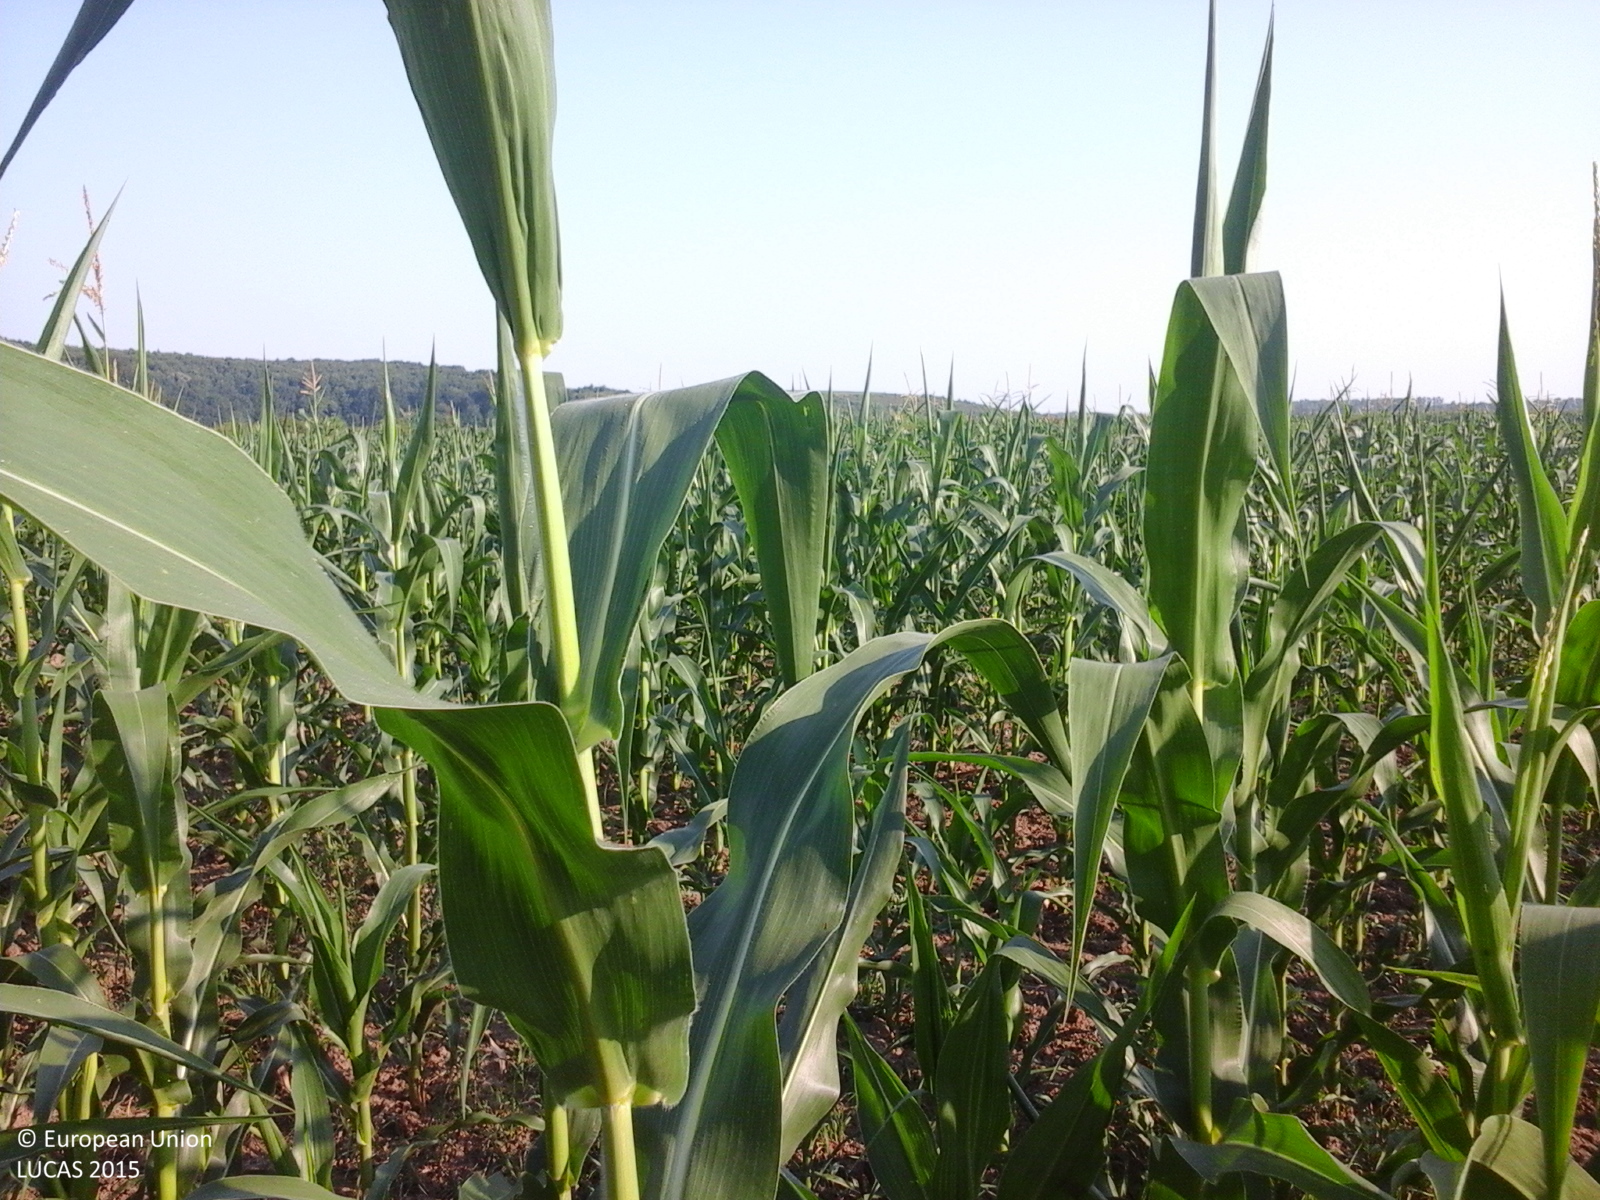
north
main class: Cropland
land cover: Maize
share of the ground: > 75 %
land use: Agriculture (excluding fallow land and kitchen gardens)
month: July
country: RO
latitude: 44.6070
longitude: 24.7561
